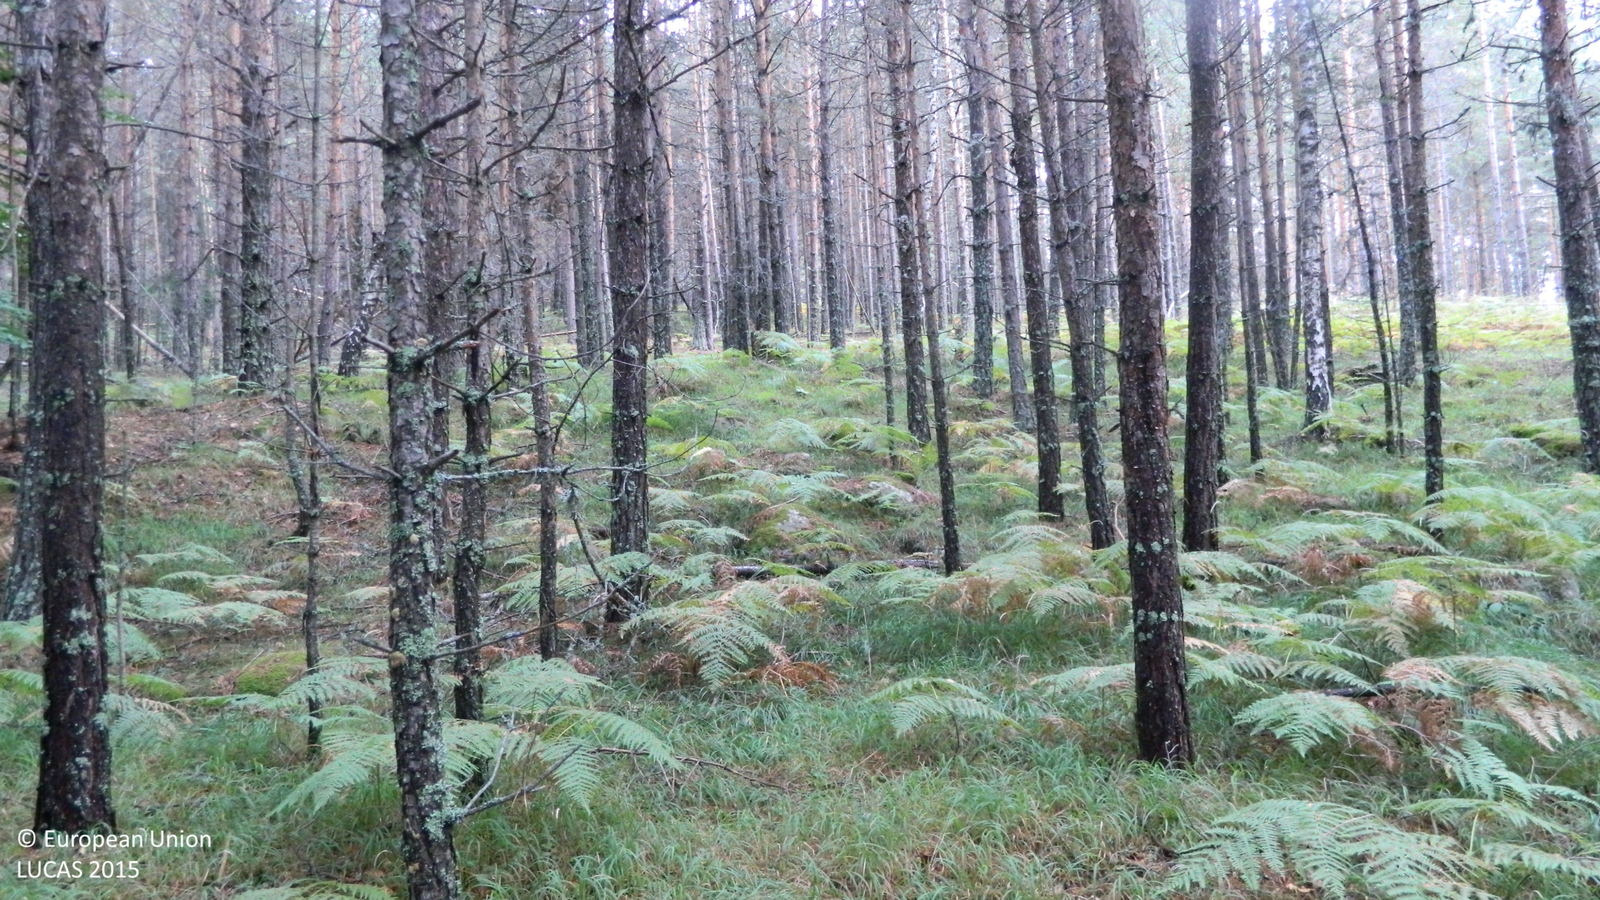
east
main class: Woodland
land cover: Pine dominated coniferous woodland
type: hemiboreal forest and nemoral coniferous forest and mixed broadleaved-coniferous forest
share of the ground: > 75 %
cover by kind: coniferous forest trees 95 %, herbaceous plants 5 %
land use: Forestry
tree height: > 5 m
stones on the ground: < 10 %
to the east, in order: Pine dominated coniferous woodland; Paved roads, cycling and walking lanes; Pine dominated coniferous woodland; Fences; Pine dominated coniferous woodland
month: September
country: BG
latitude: 41.6480
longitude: 24.0702
